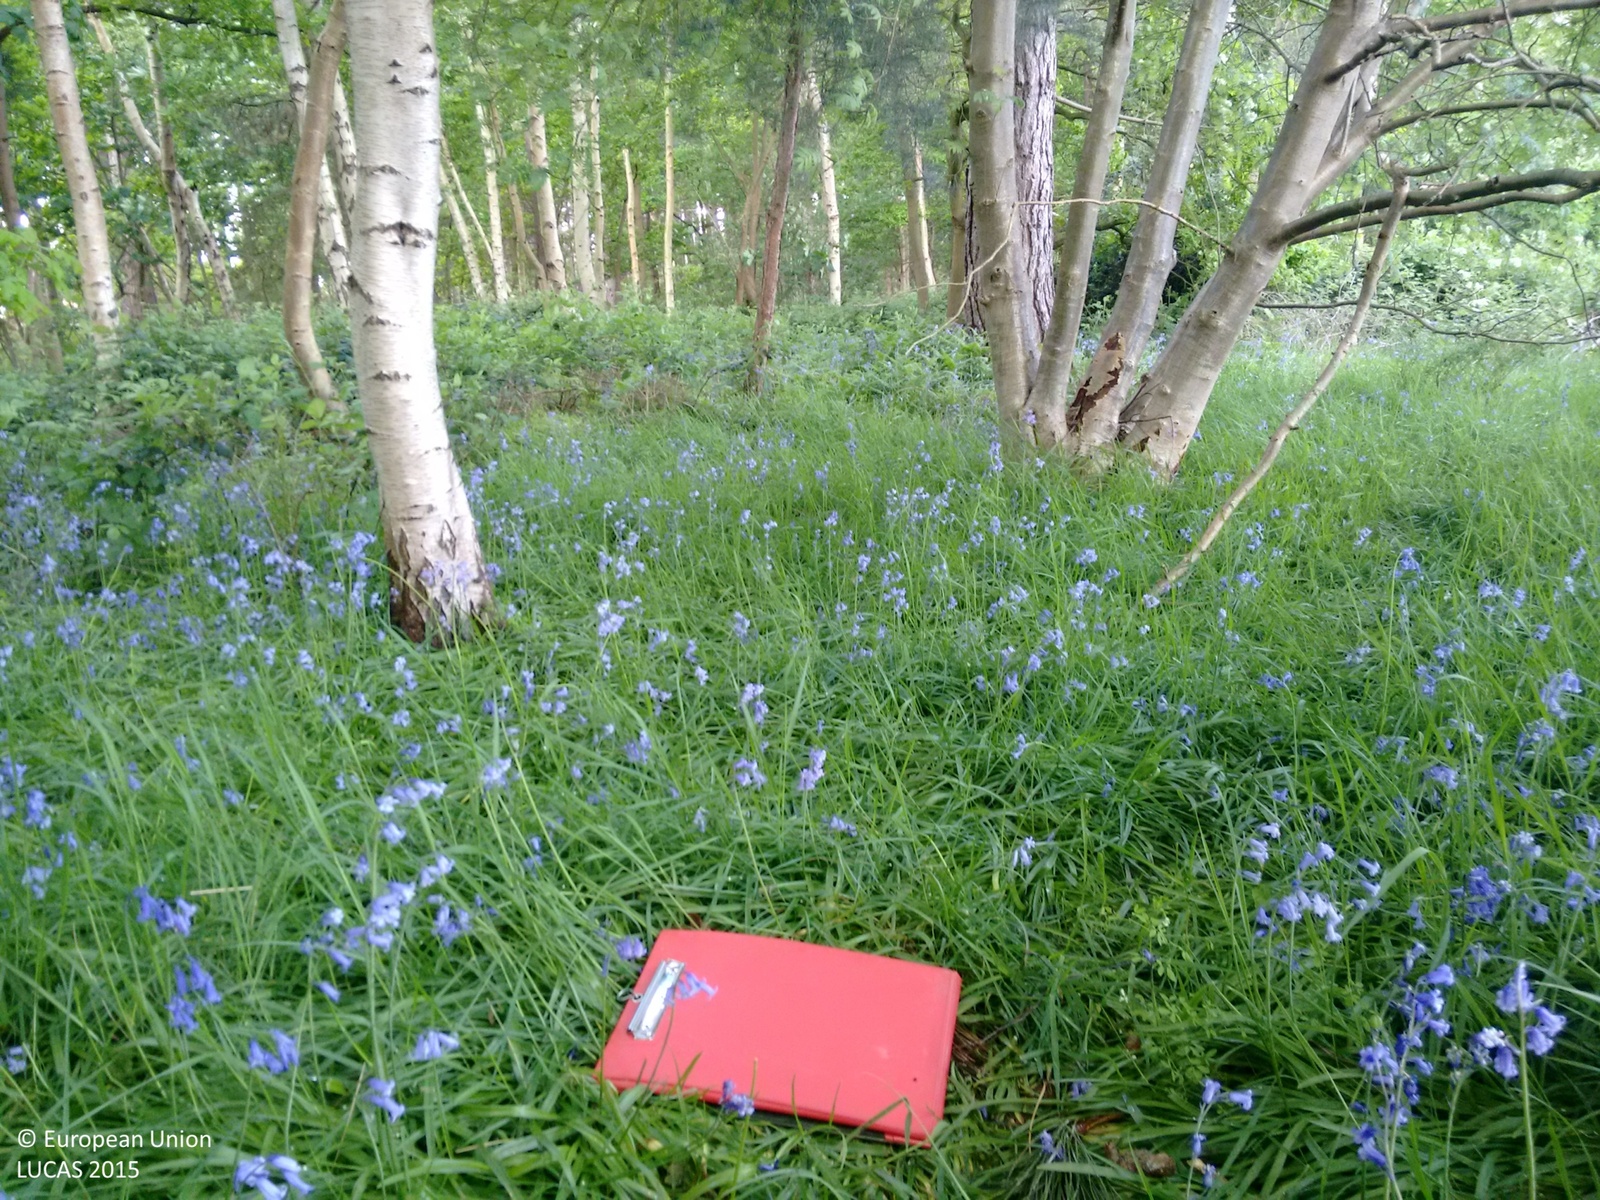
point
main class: Woodland
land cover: Broadleaved woodland
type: mesophytic deciduous forest
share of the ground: > 75 %
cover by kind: broadleaved forest trees 100 %
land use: Semi-natural and natural areas not in use
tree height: > 5 m
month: May
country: GB
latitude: 53.5129
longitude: -1.0372
